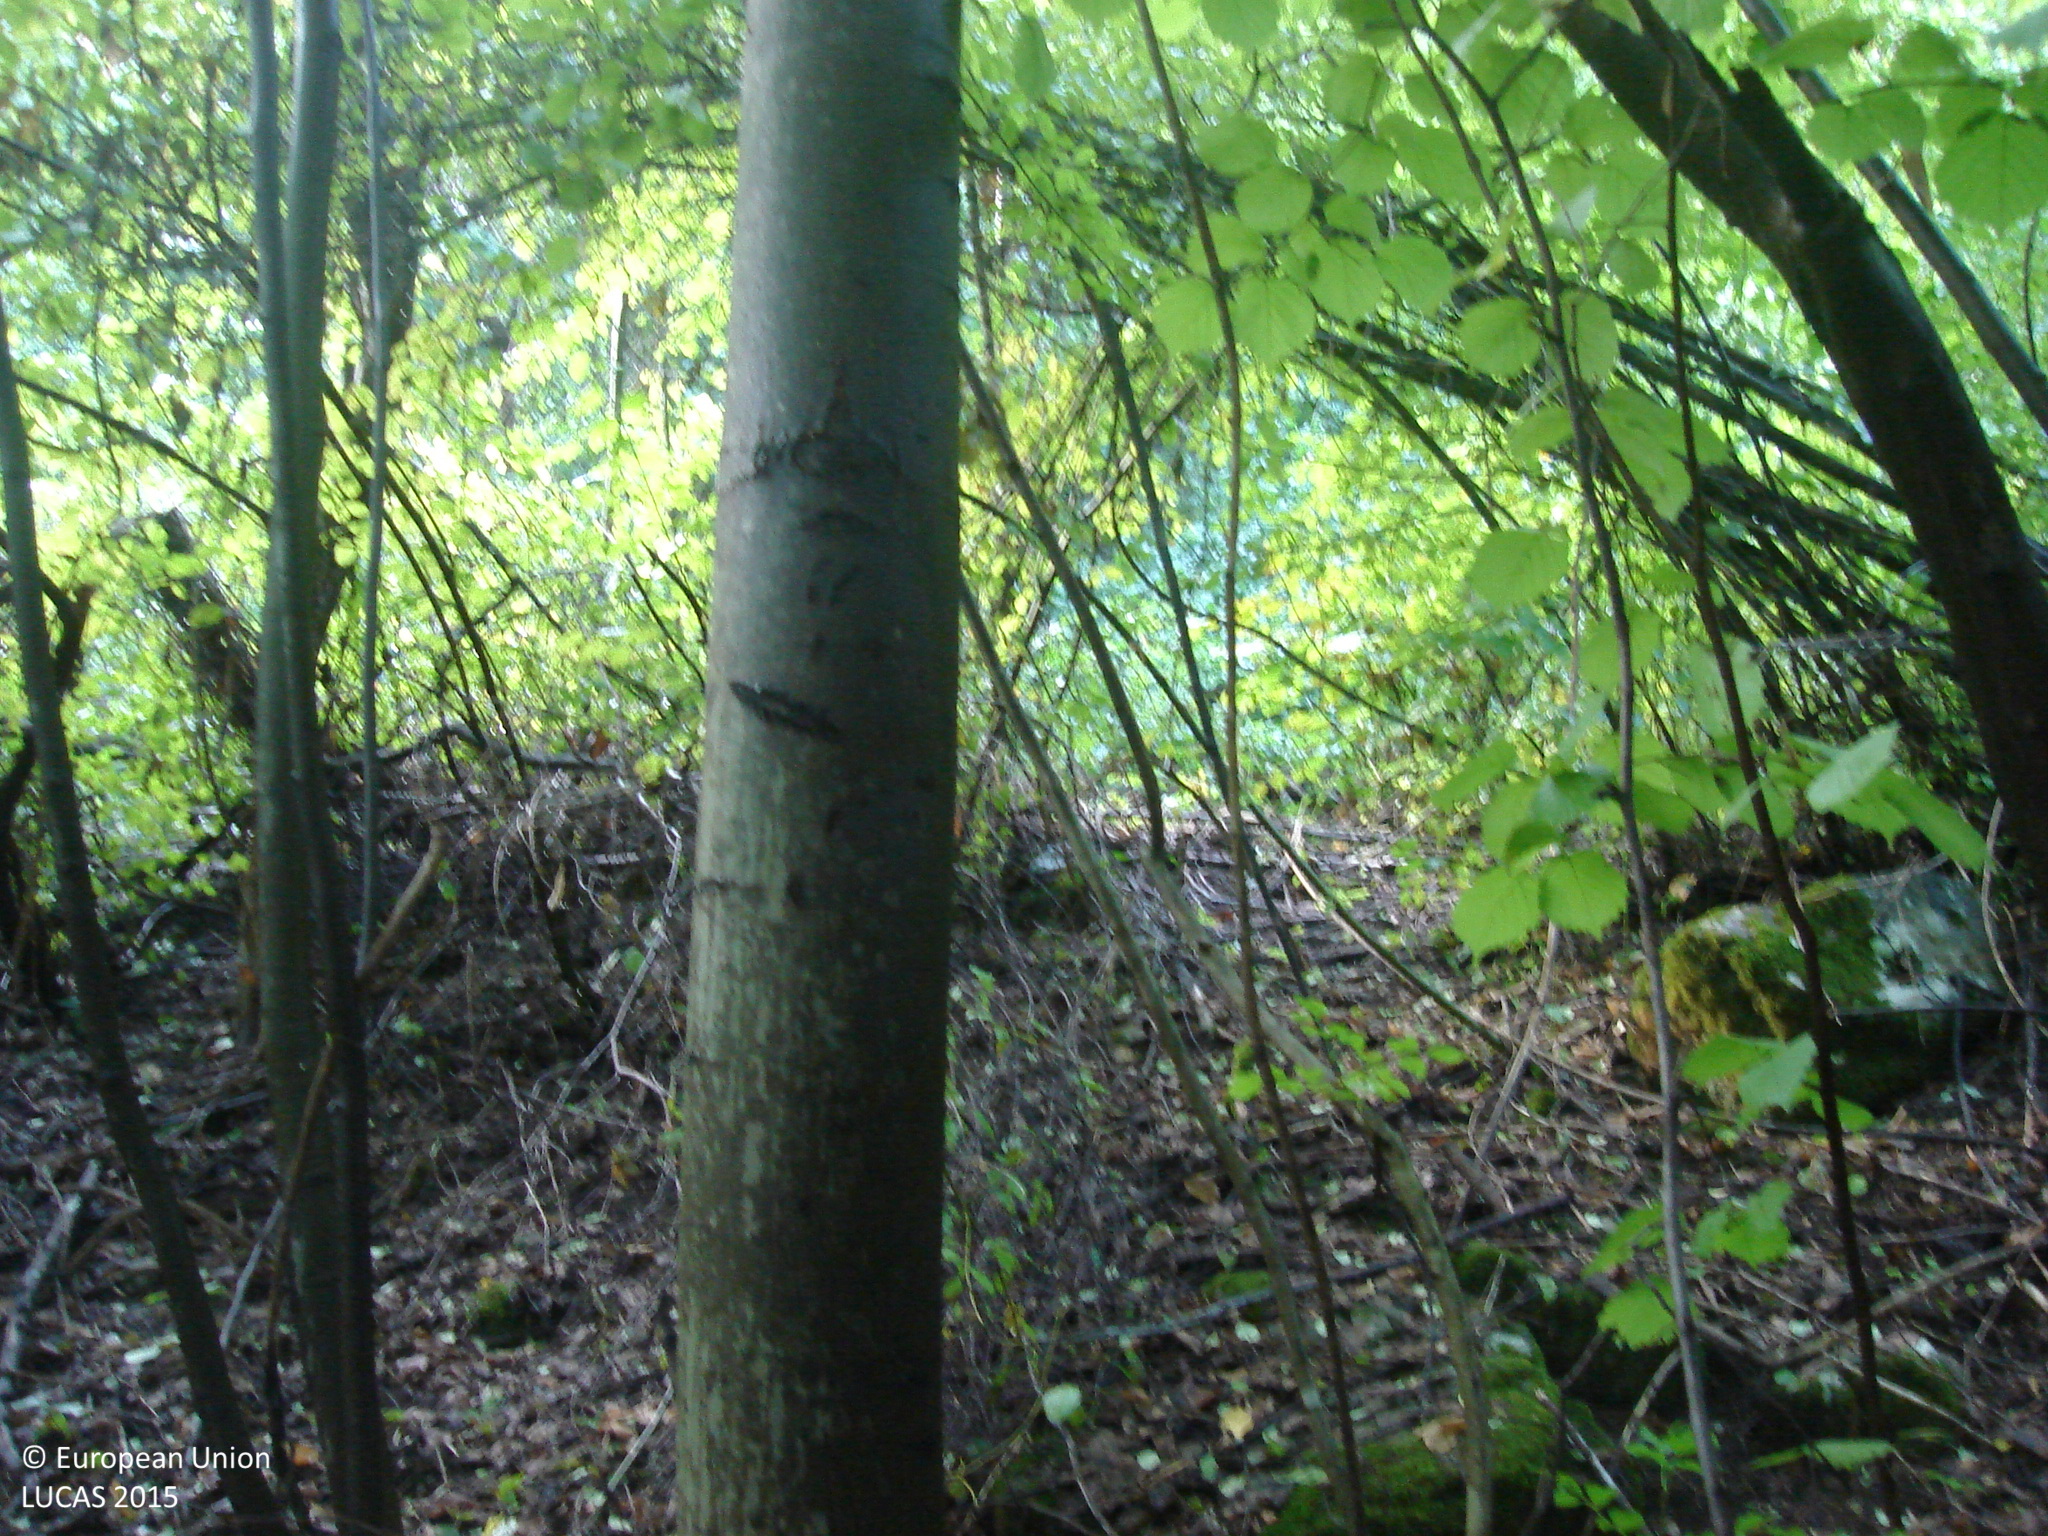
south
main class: Woodland
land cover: Broadleaved woodland
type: mesophytic deciduous forest
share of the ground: > 75 %
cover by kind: broadleaved forest trees 80 %, unconsolidated bare surface 10 %, shrubs 5 %, lichens and mosses 5 %
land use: Forestry
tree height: > 5 m
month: October
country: BG
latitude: 43.0910
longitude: 23.4178
